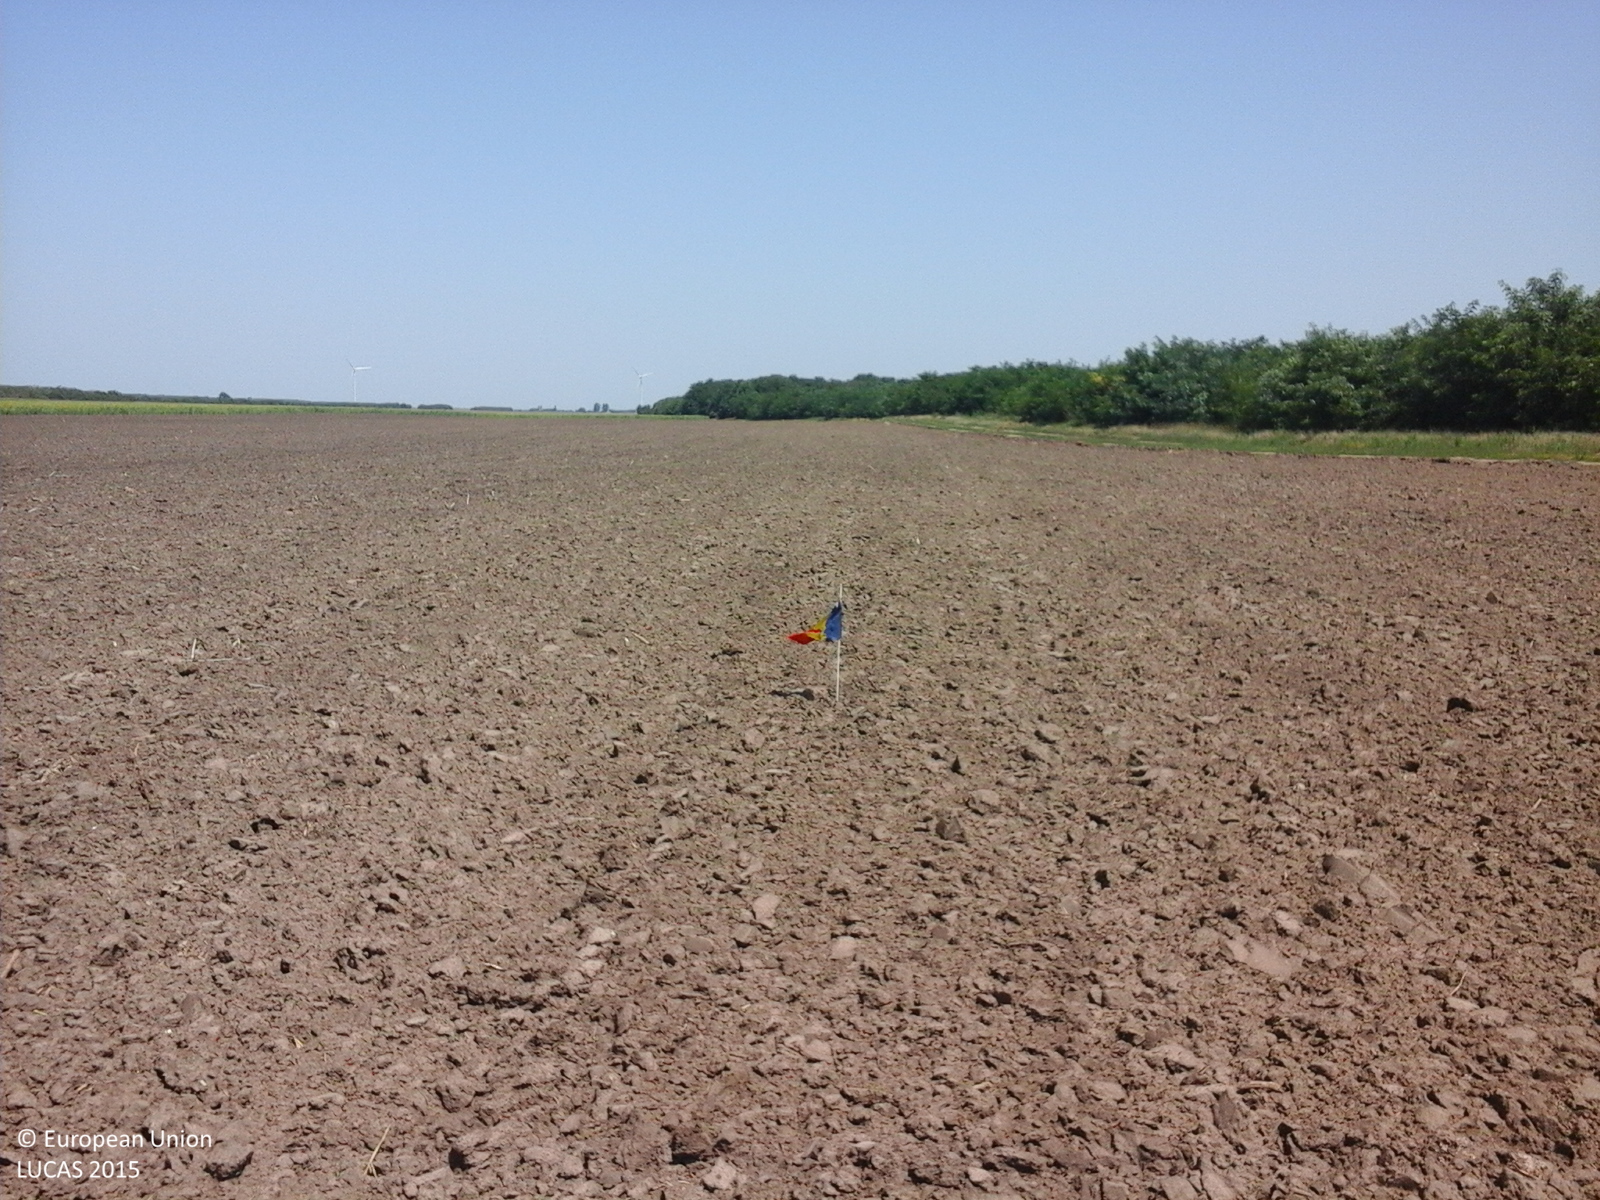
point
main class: Cropland
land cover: Rape and turnip rape
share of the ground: < 10 %
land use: Agriculture (excluding fallow land and kitchen gardens)
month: July
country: RO
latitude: 44.8962
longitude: 26.9351
